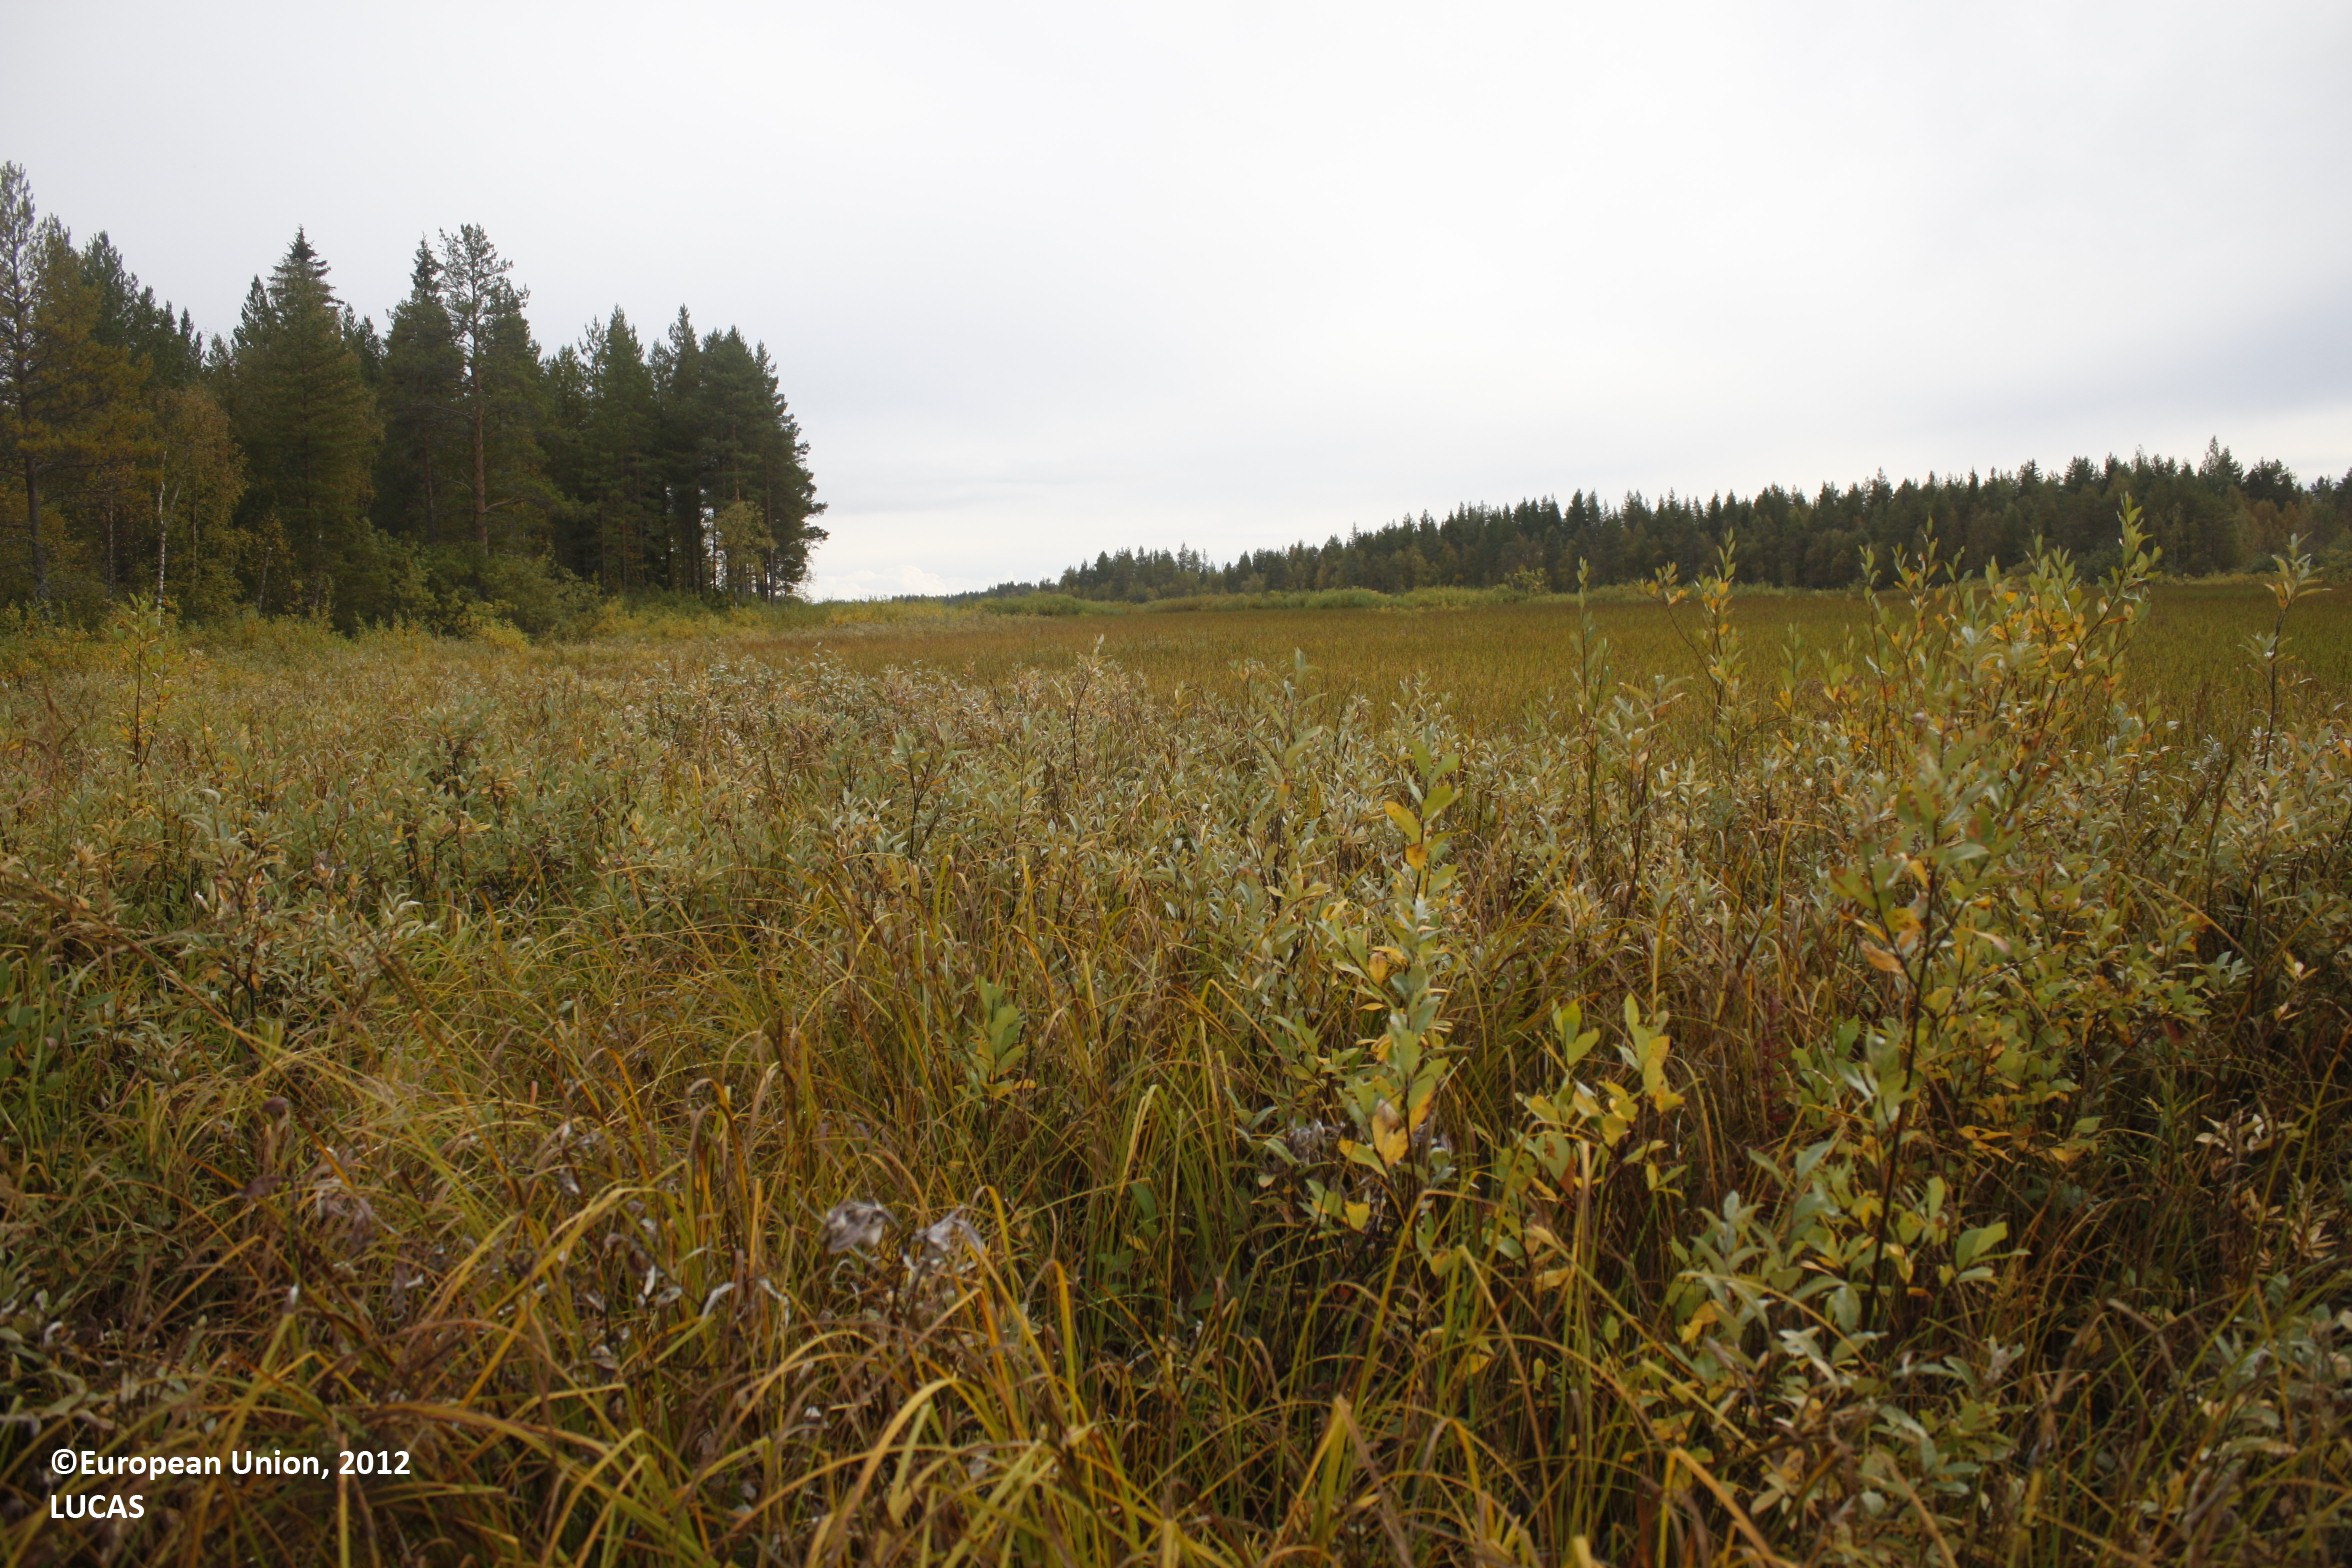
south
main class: Woodland
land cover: Pine dominated mixed woodland
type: mire and swamp forests
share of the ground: 50 - 75 %
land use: Forestry
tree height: > 5 m
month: September
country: FI
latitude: 65.3144
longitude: 26.9617
